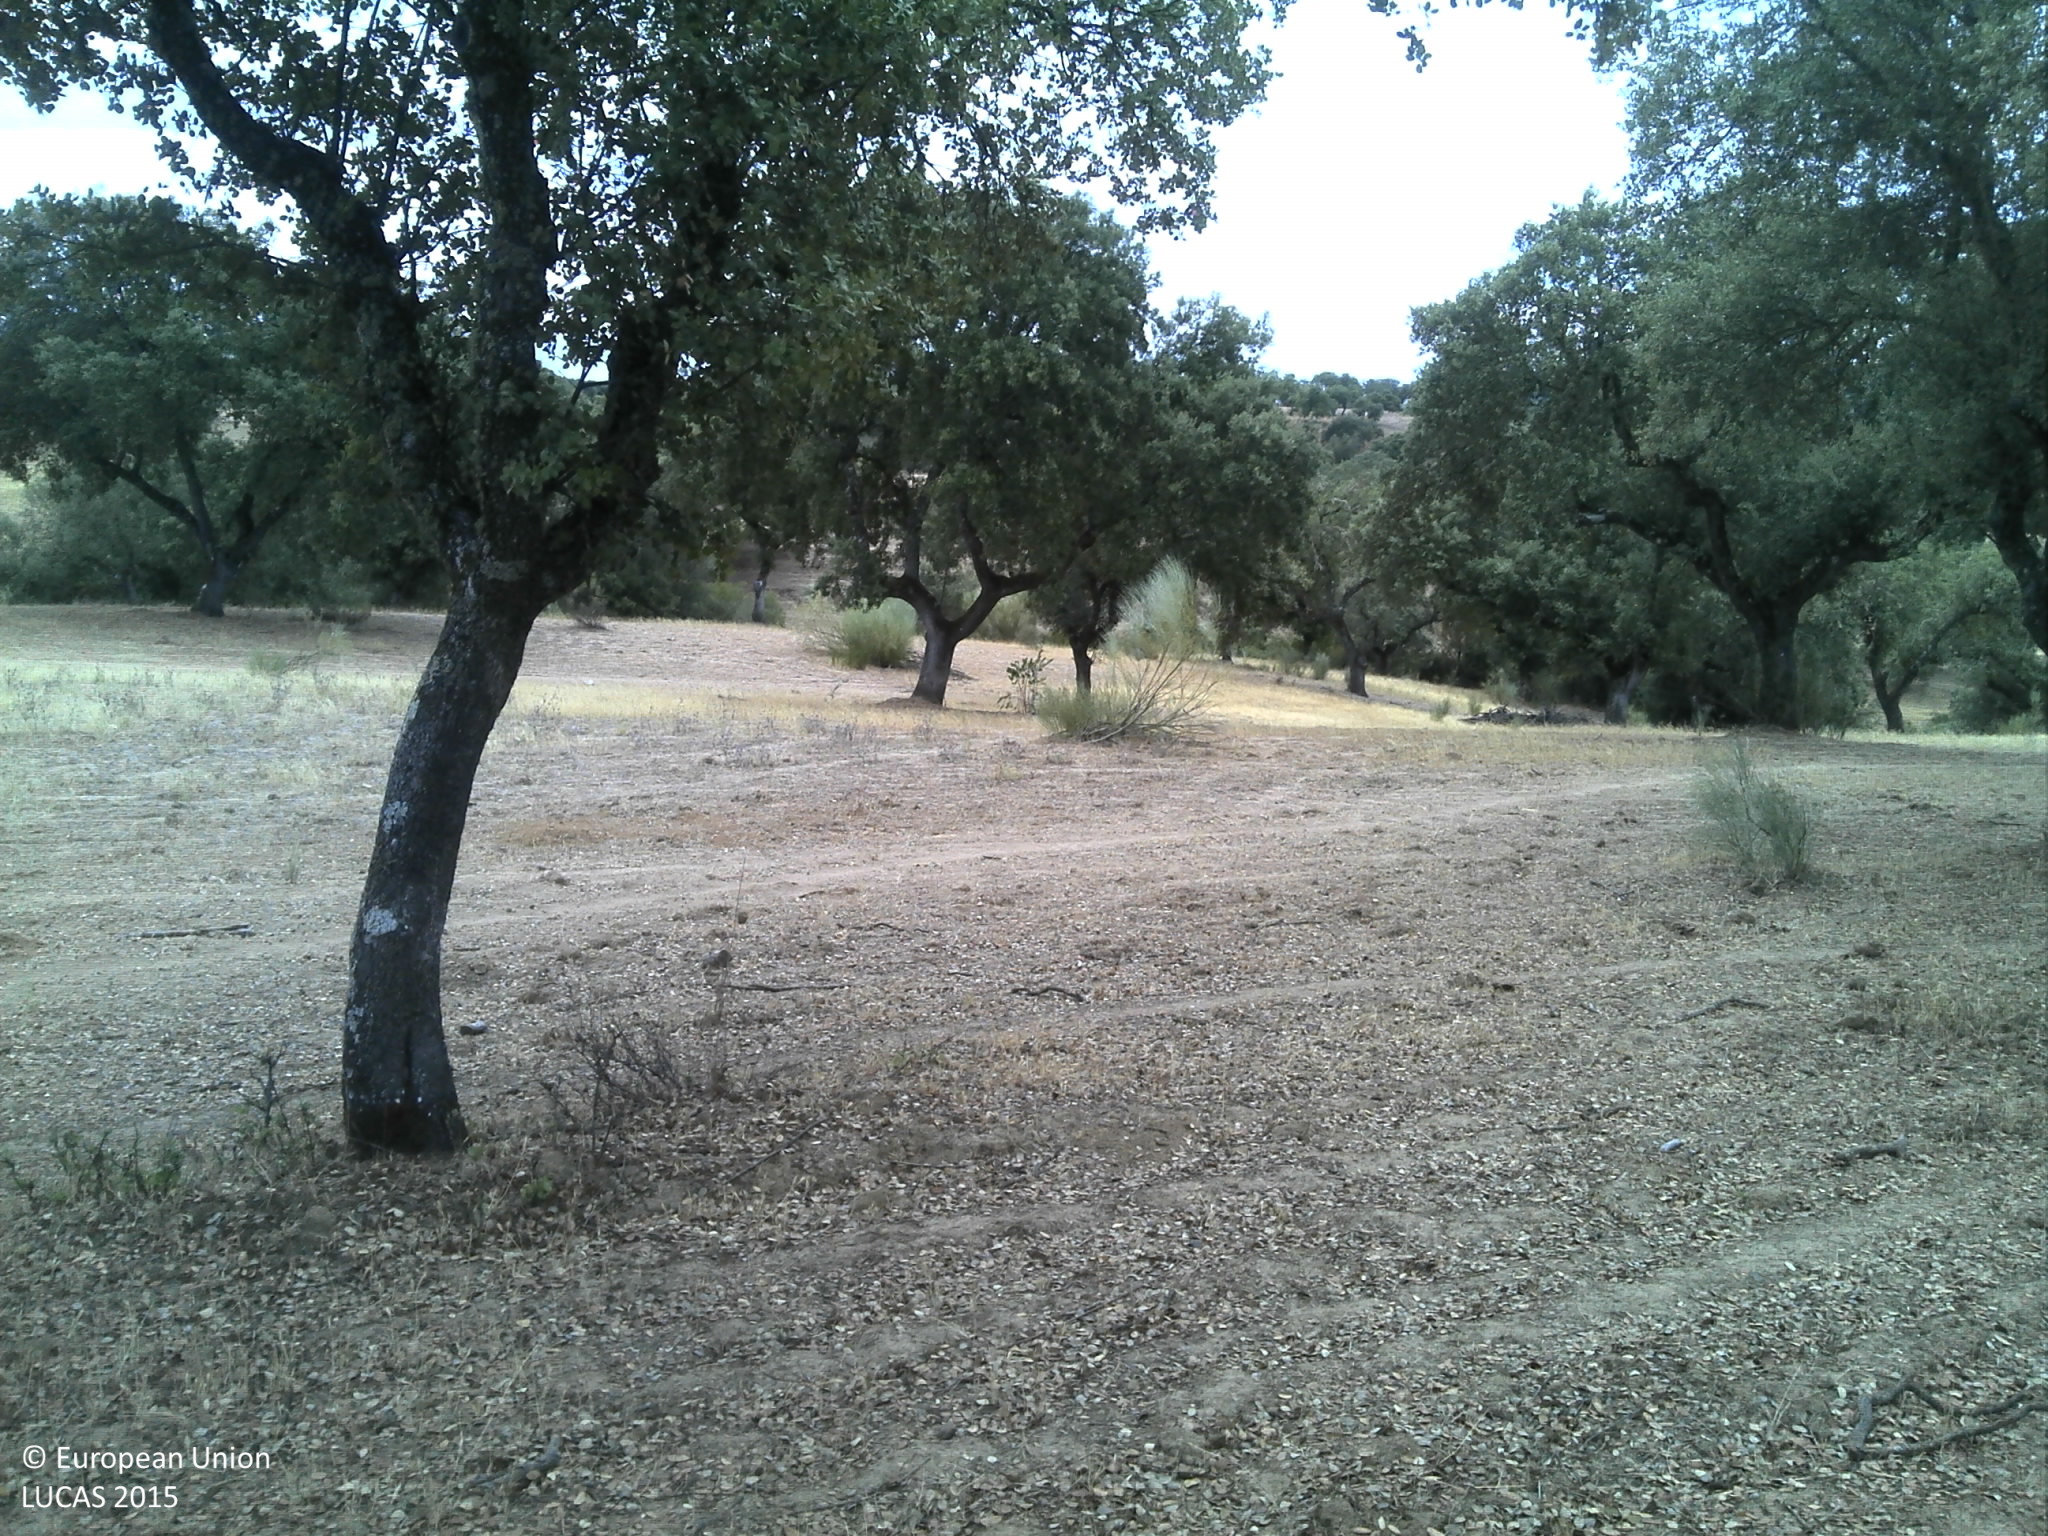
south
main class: Woodland
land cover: Broadleaved woodland
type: broadleaved evergreen forest
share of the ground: 25 - 50 %
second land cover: Spontaneously vegetated surfaces
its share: 10 - 25 %
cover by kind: broadleaved forest trees 45 %, unconsolidated bare surface 40 %, herbaceous plants 15 %
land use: Forestry
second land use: Agriculture (excluding fallow land and kitchen gardens)
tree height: > 5 m
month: July
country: PT
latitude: 39.7938
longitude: -7.3676
